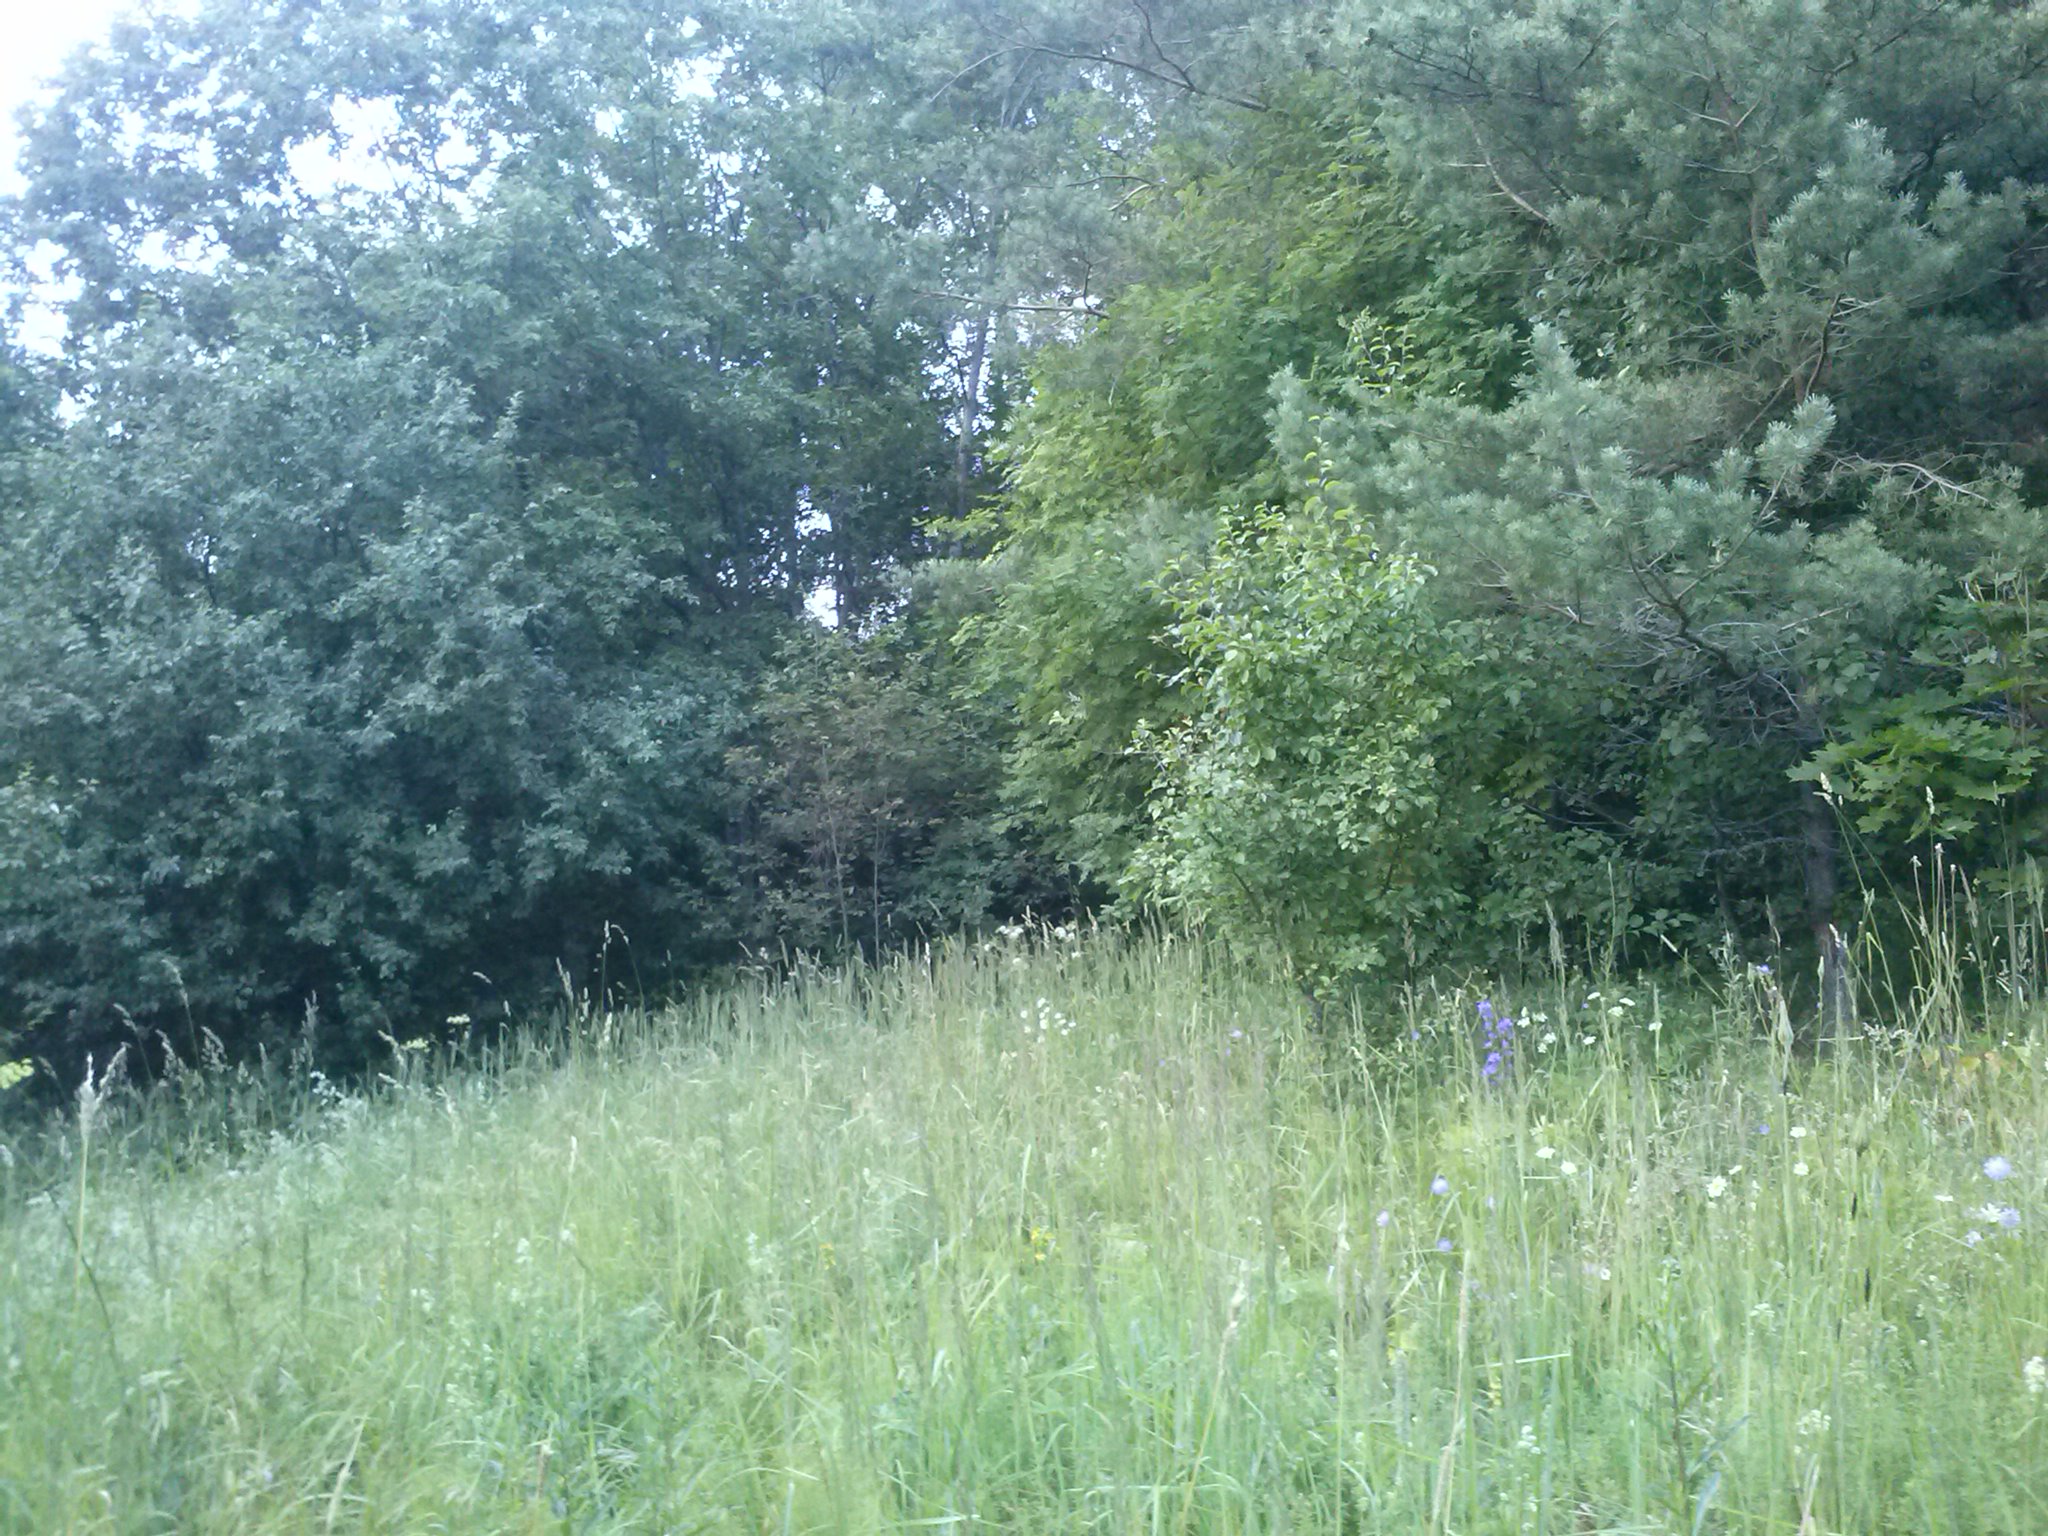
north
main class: Grassland
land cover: Spontaneously vegetated surfaces
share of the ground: > 75 %
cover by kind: herbaceous plants 95 %, shrubs 5 %
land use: Semi-natural and natural areas not in use
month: July
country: LV
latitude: 56.8521
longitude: 27.5102
